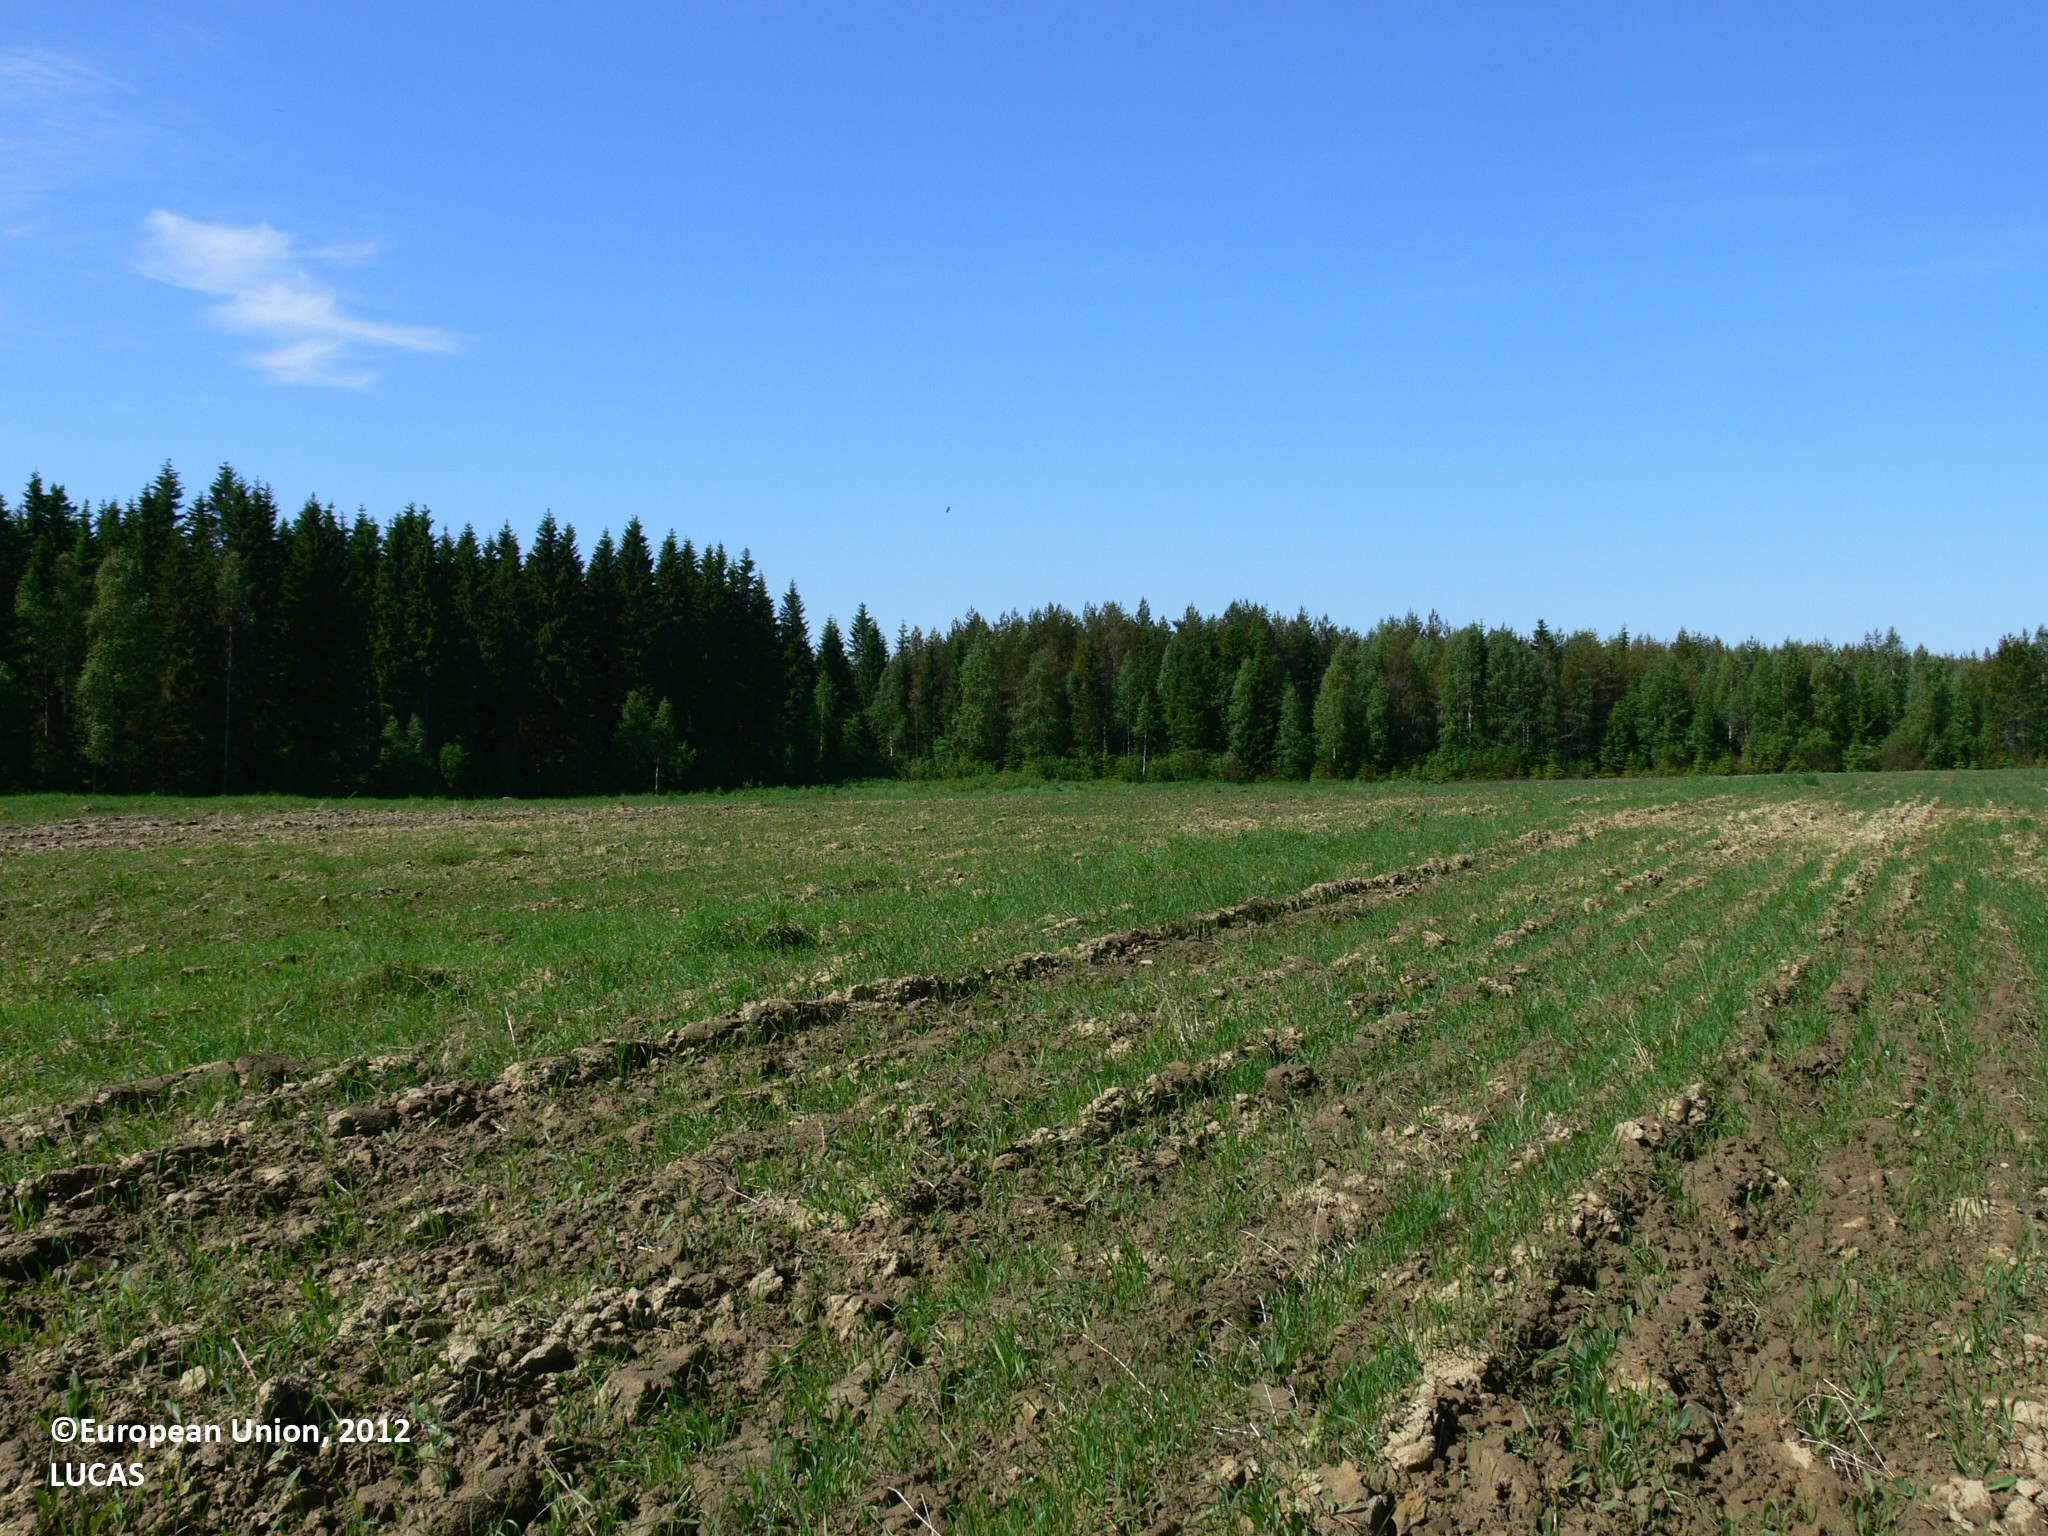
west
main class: Grassland
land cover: Spontaneously vegetated surfaces
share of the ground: < 10 %
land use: Fallow land
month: June
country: FI
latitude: 62.3193
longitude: 30.3657
